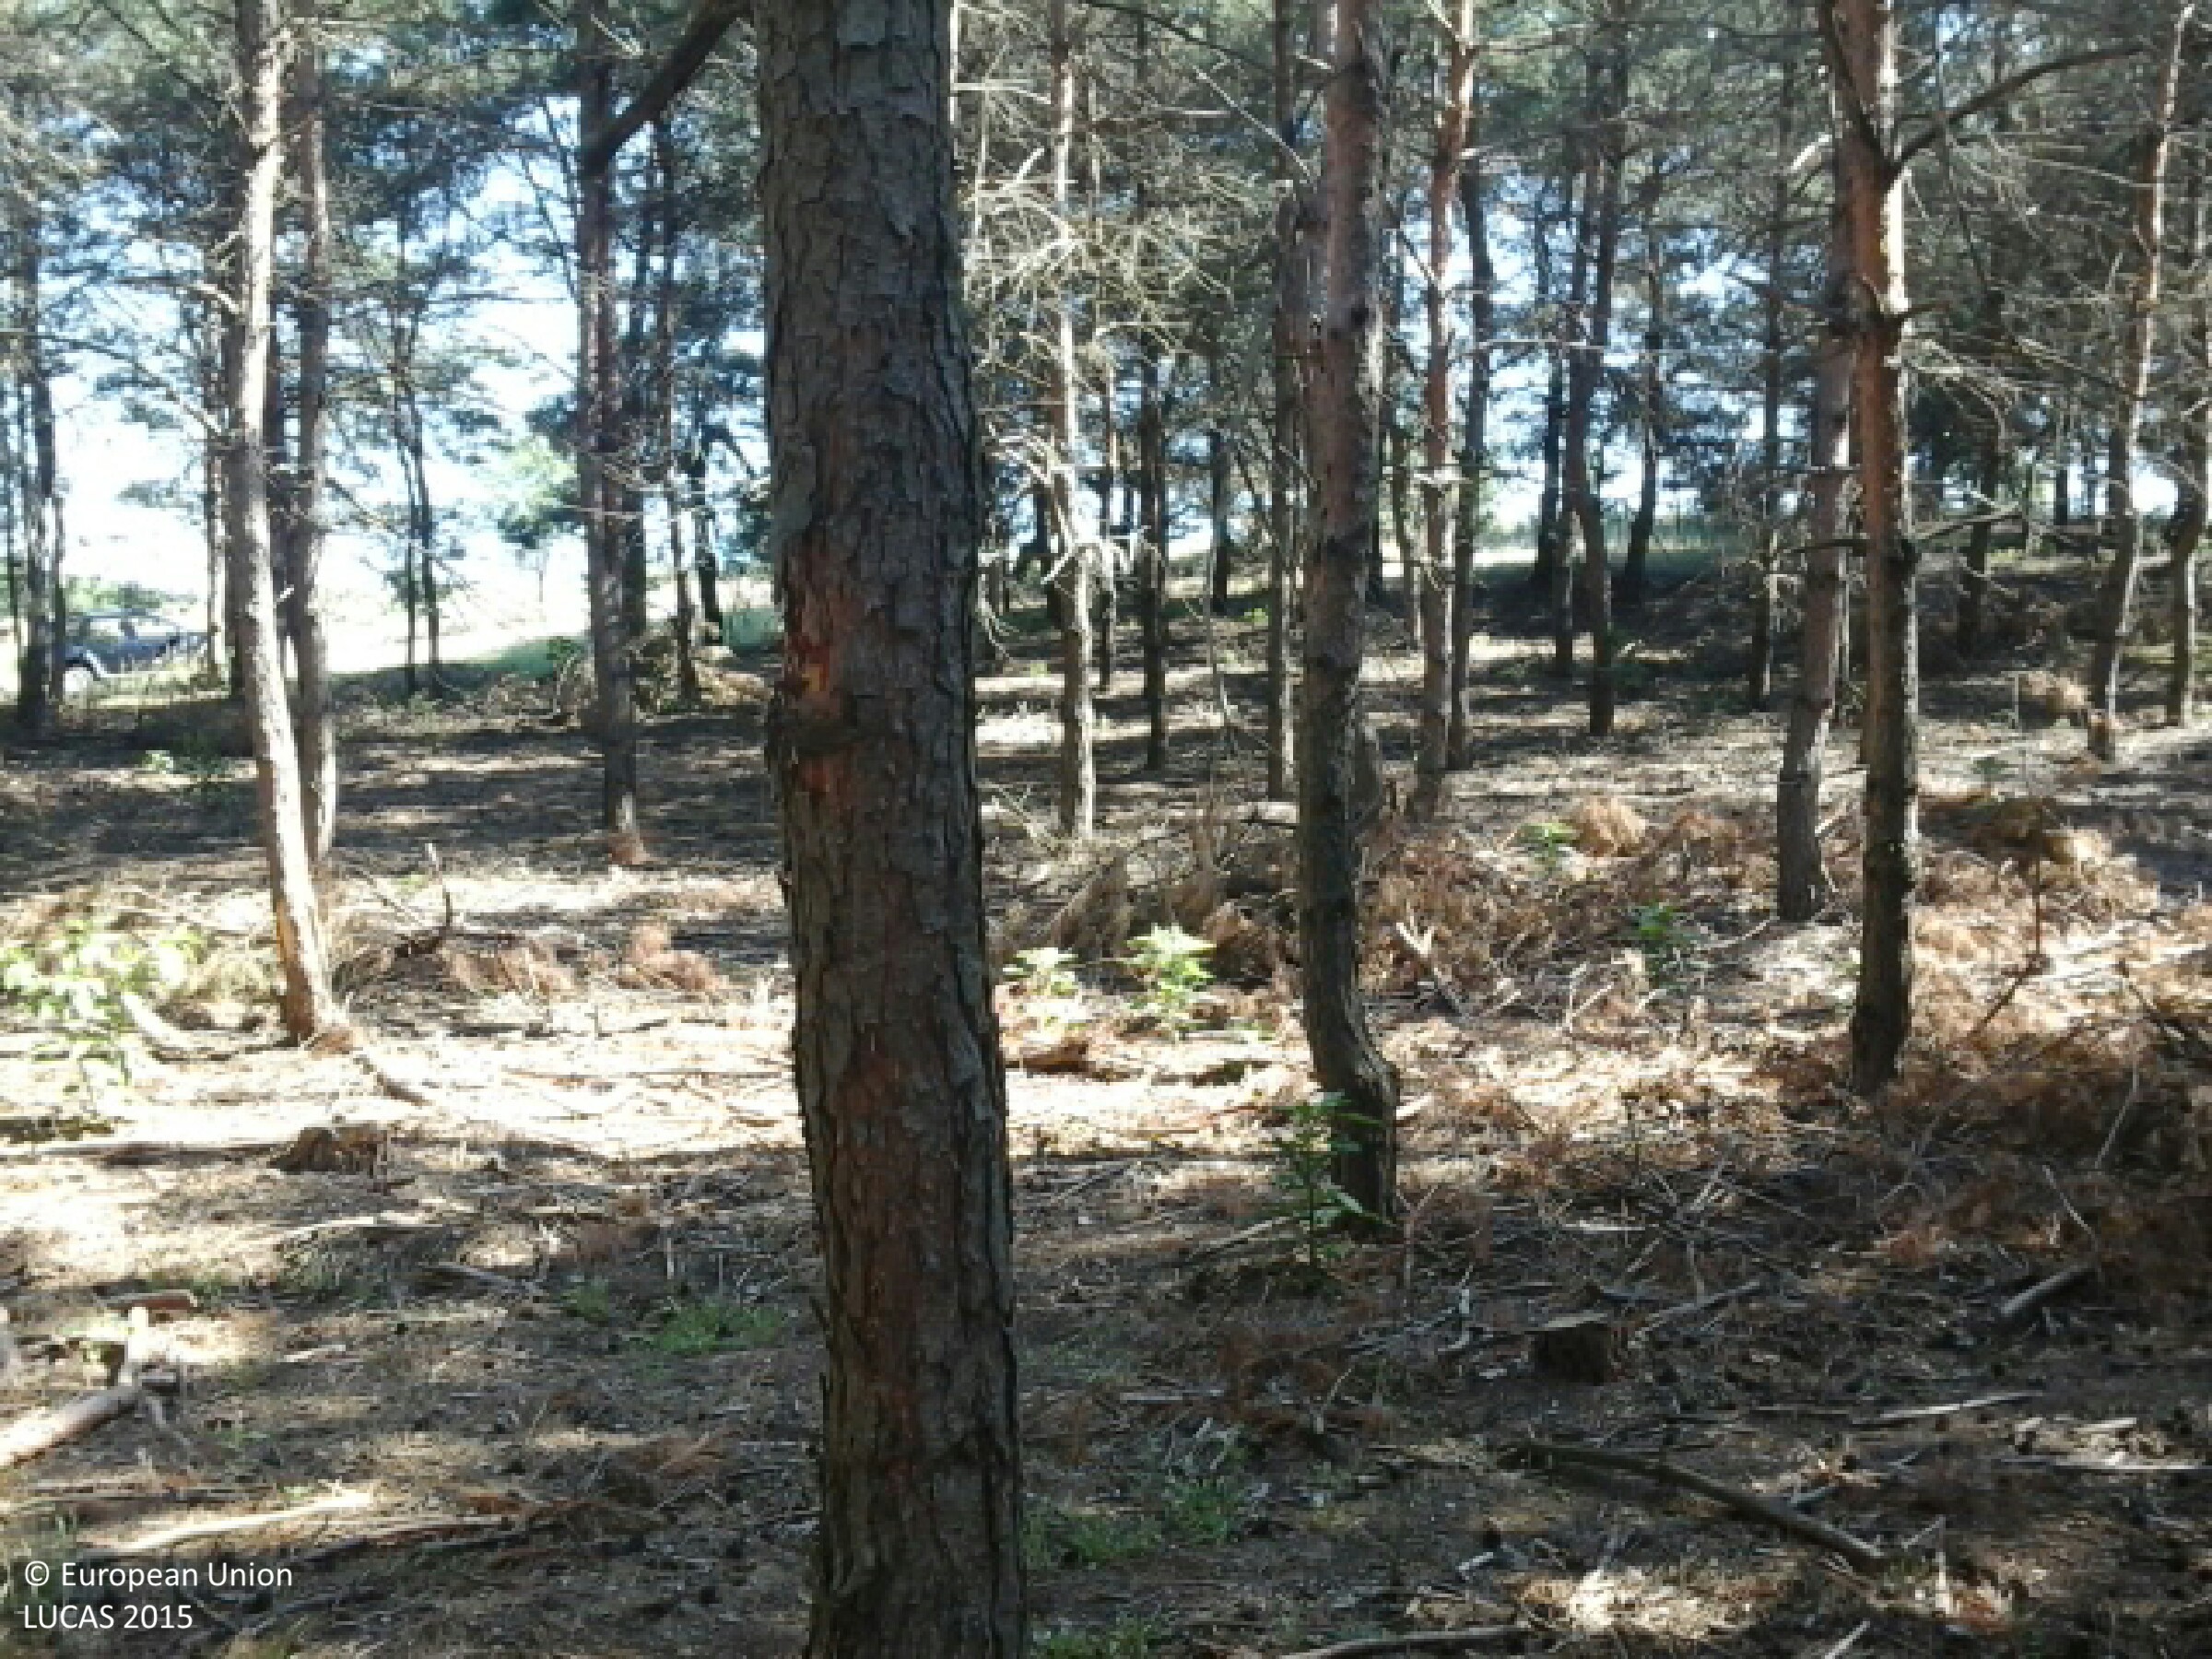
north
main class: Woodland
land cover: Pine dominated coniferous woodland
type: hemiboreal forest and nemoral coniferous forest and mixed broadleaved-coniferous forest
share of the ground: > 75 %
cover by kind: coniferous forest trees 85 %, consolidated bare surface 10 %, shrubs 5 %
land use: Forestry
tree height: > 5 m
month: July
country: HU
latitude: 47.9613
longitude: 22.2019
